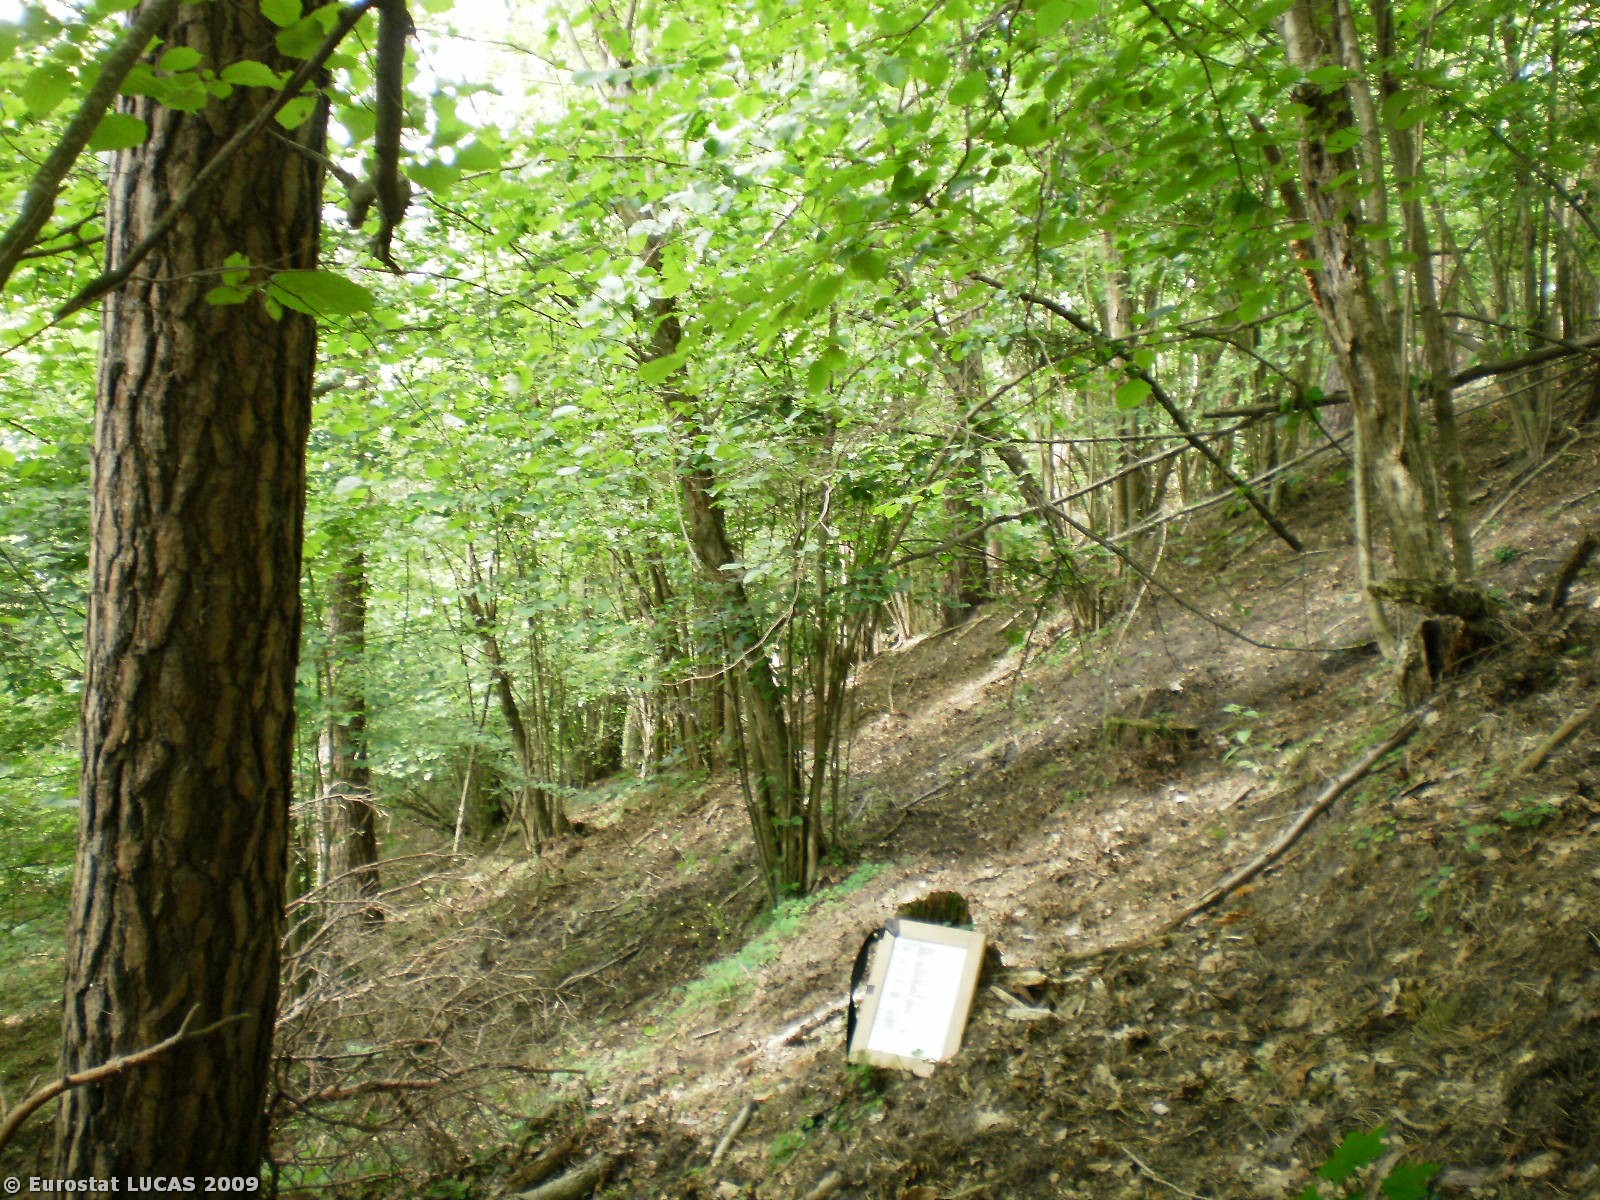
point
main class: Woodland
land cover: Mixed woodland
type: hemiboreal forest and nemoral coniferous forest and mixed broadleaved-coniferous forest
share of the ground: > 75 %
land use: Forestry
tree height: > 5 m
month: July
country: PL
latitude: 53.5608
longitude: 20.4994
